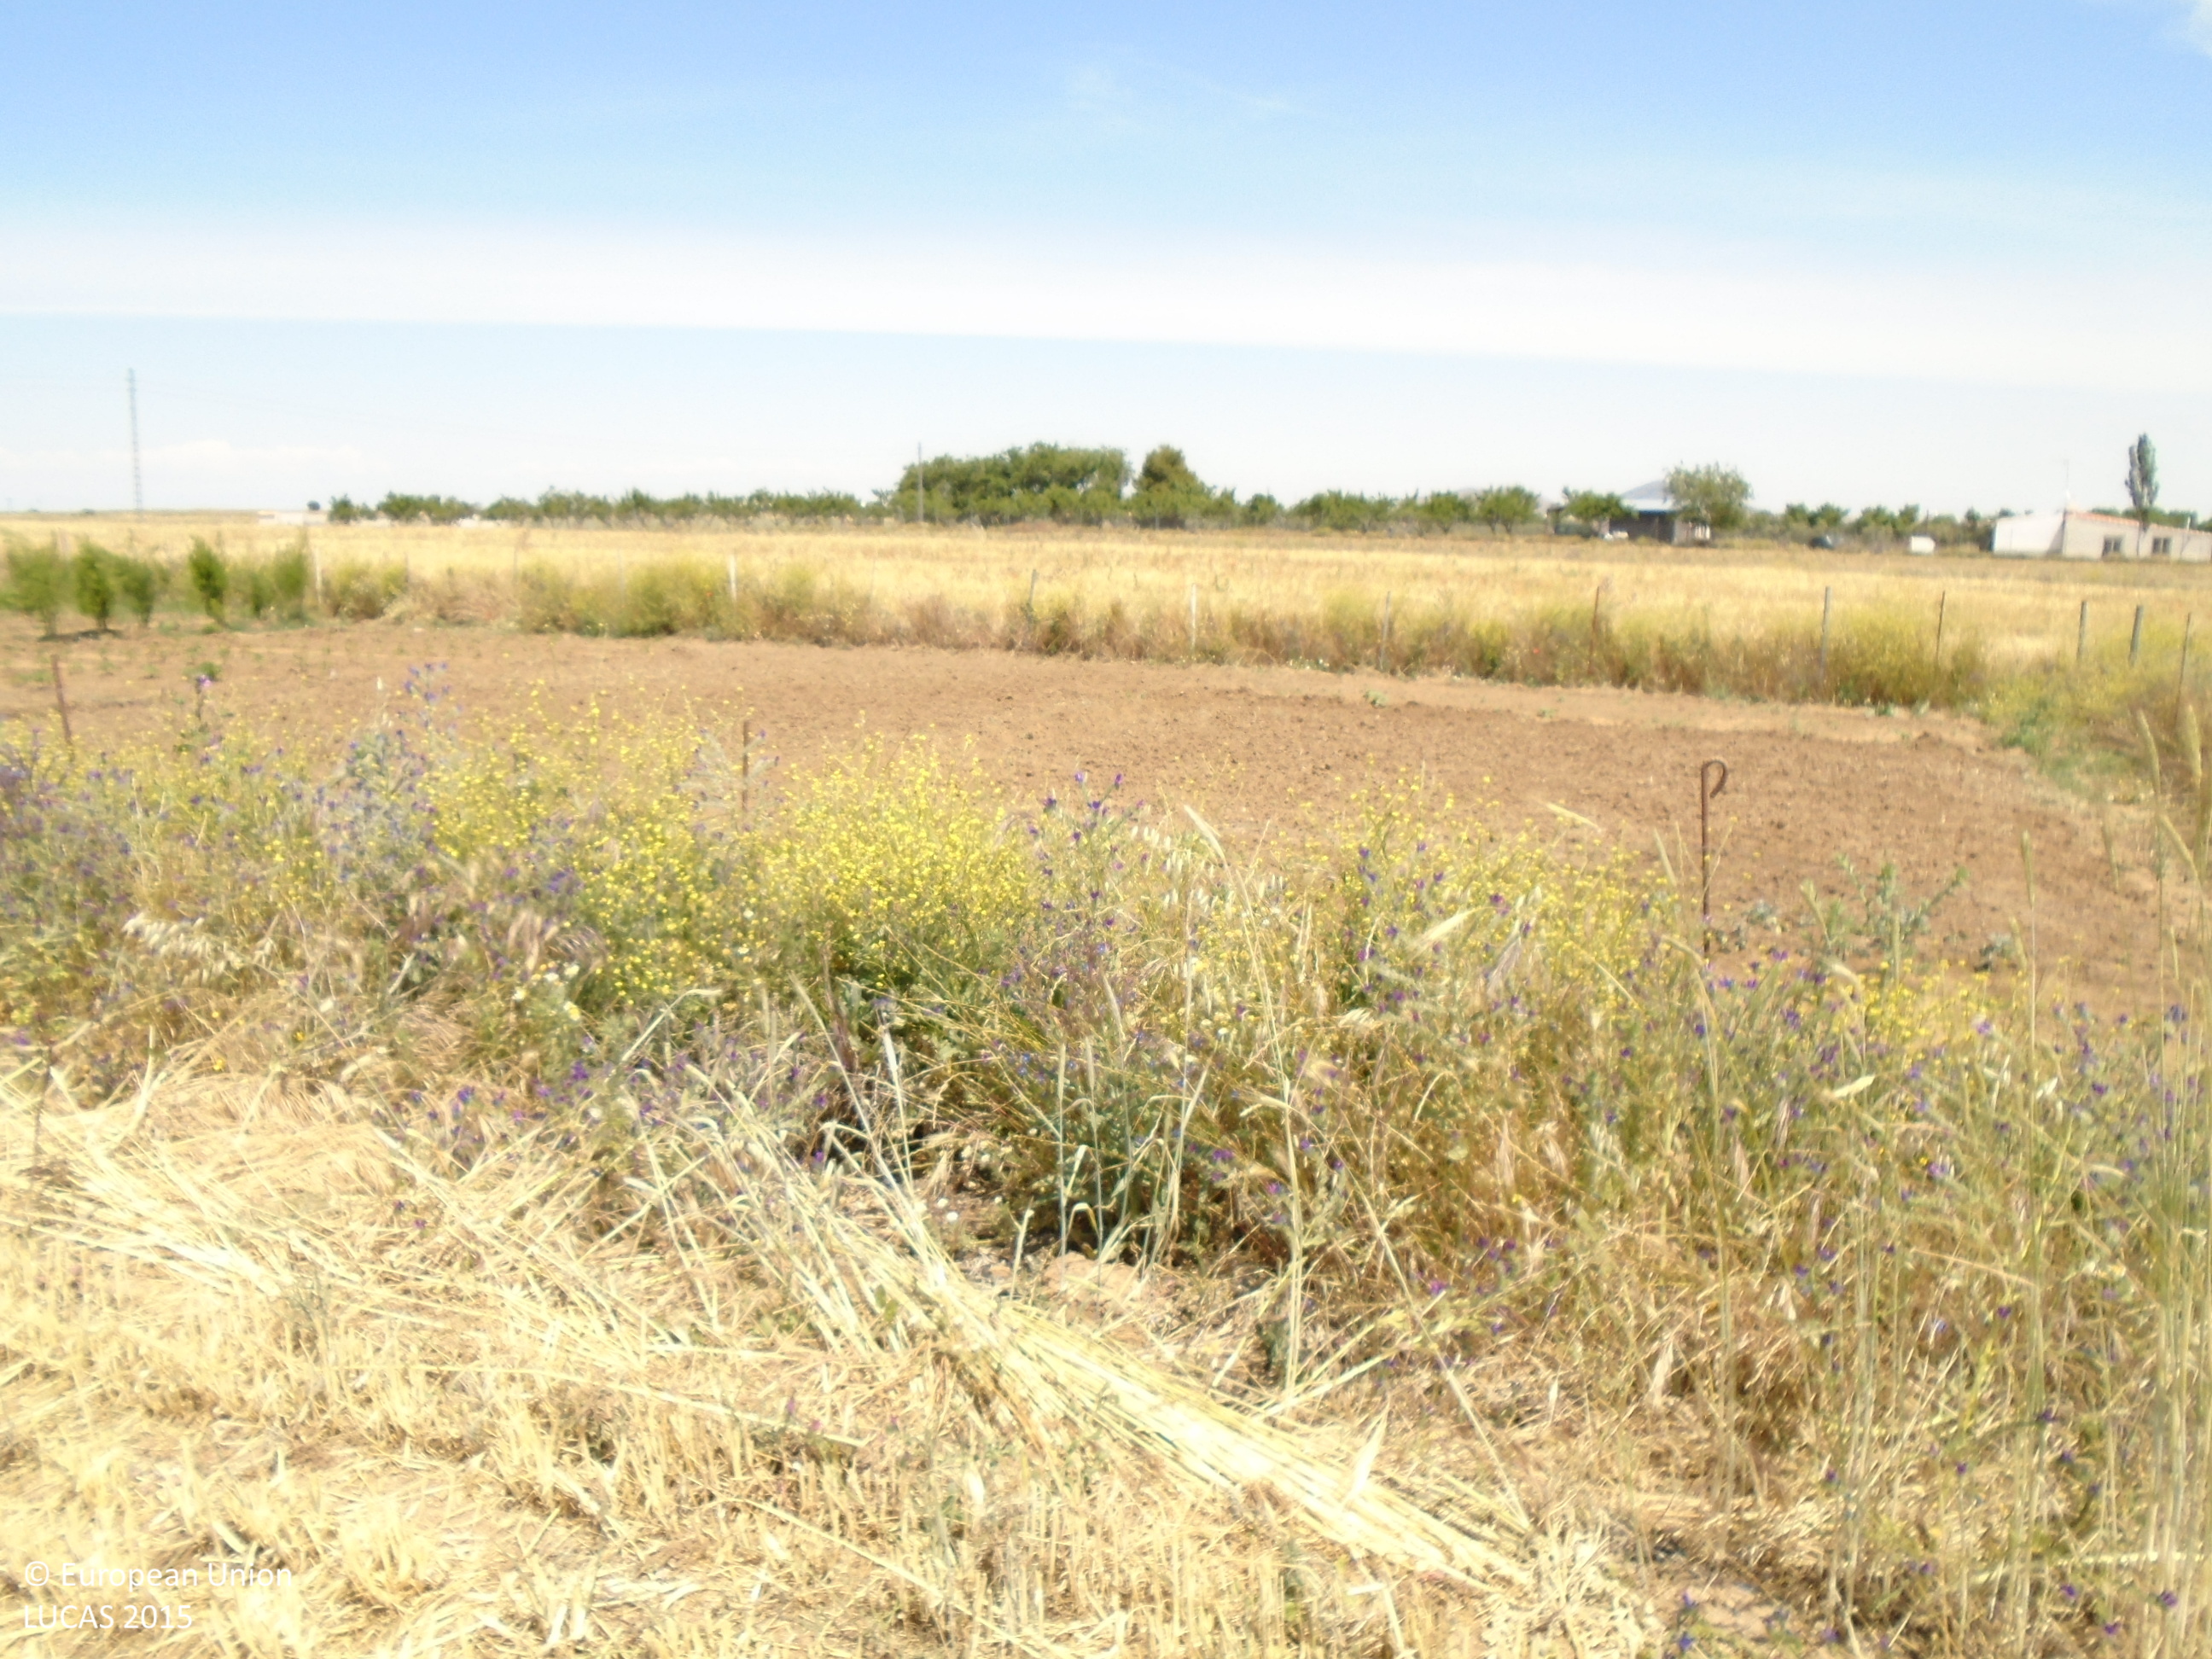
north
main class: Cropland
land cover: Rye
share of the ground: > 75 %
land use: Agriculture (excluding fallow land and kitchen gardens)
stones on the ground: < 10 %
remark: Harvested field
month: May
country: ES
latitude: 39.6447
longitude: -4.2394
